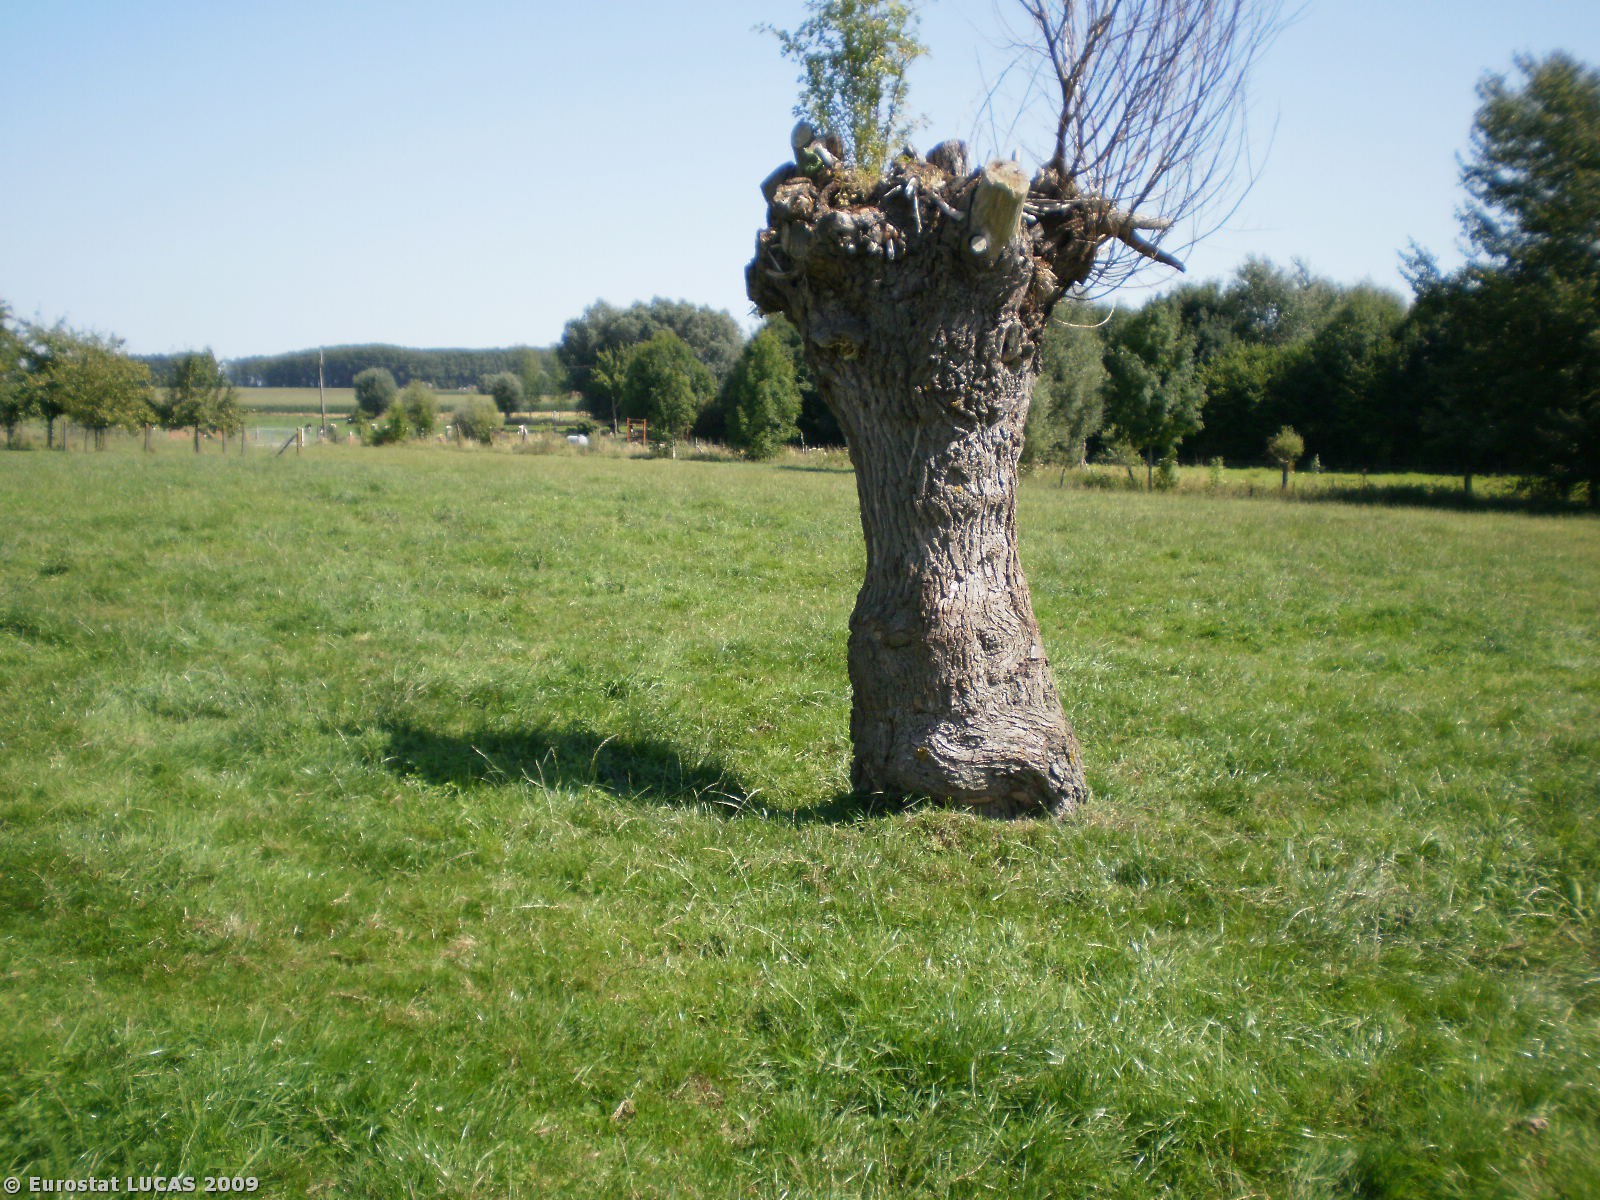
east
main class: Grassland
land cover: Grassland without tree/shrub cover
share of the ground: > 75 %
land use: Agriculture (excluding fallow land and kitchen gardens)
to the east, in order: Grassland without tree/shrub cover; Fences; Ditches and canals; Fences; Grassland without tree/shrub cover; Fences; Grass margins; Paved roads, cycling and walking lanes; Grass margins; Fences; Grassland without tree/shrub cover
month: August
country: BE
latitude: 50.7907
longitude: 3.7942
